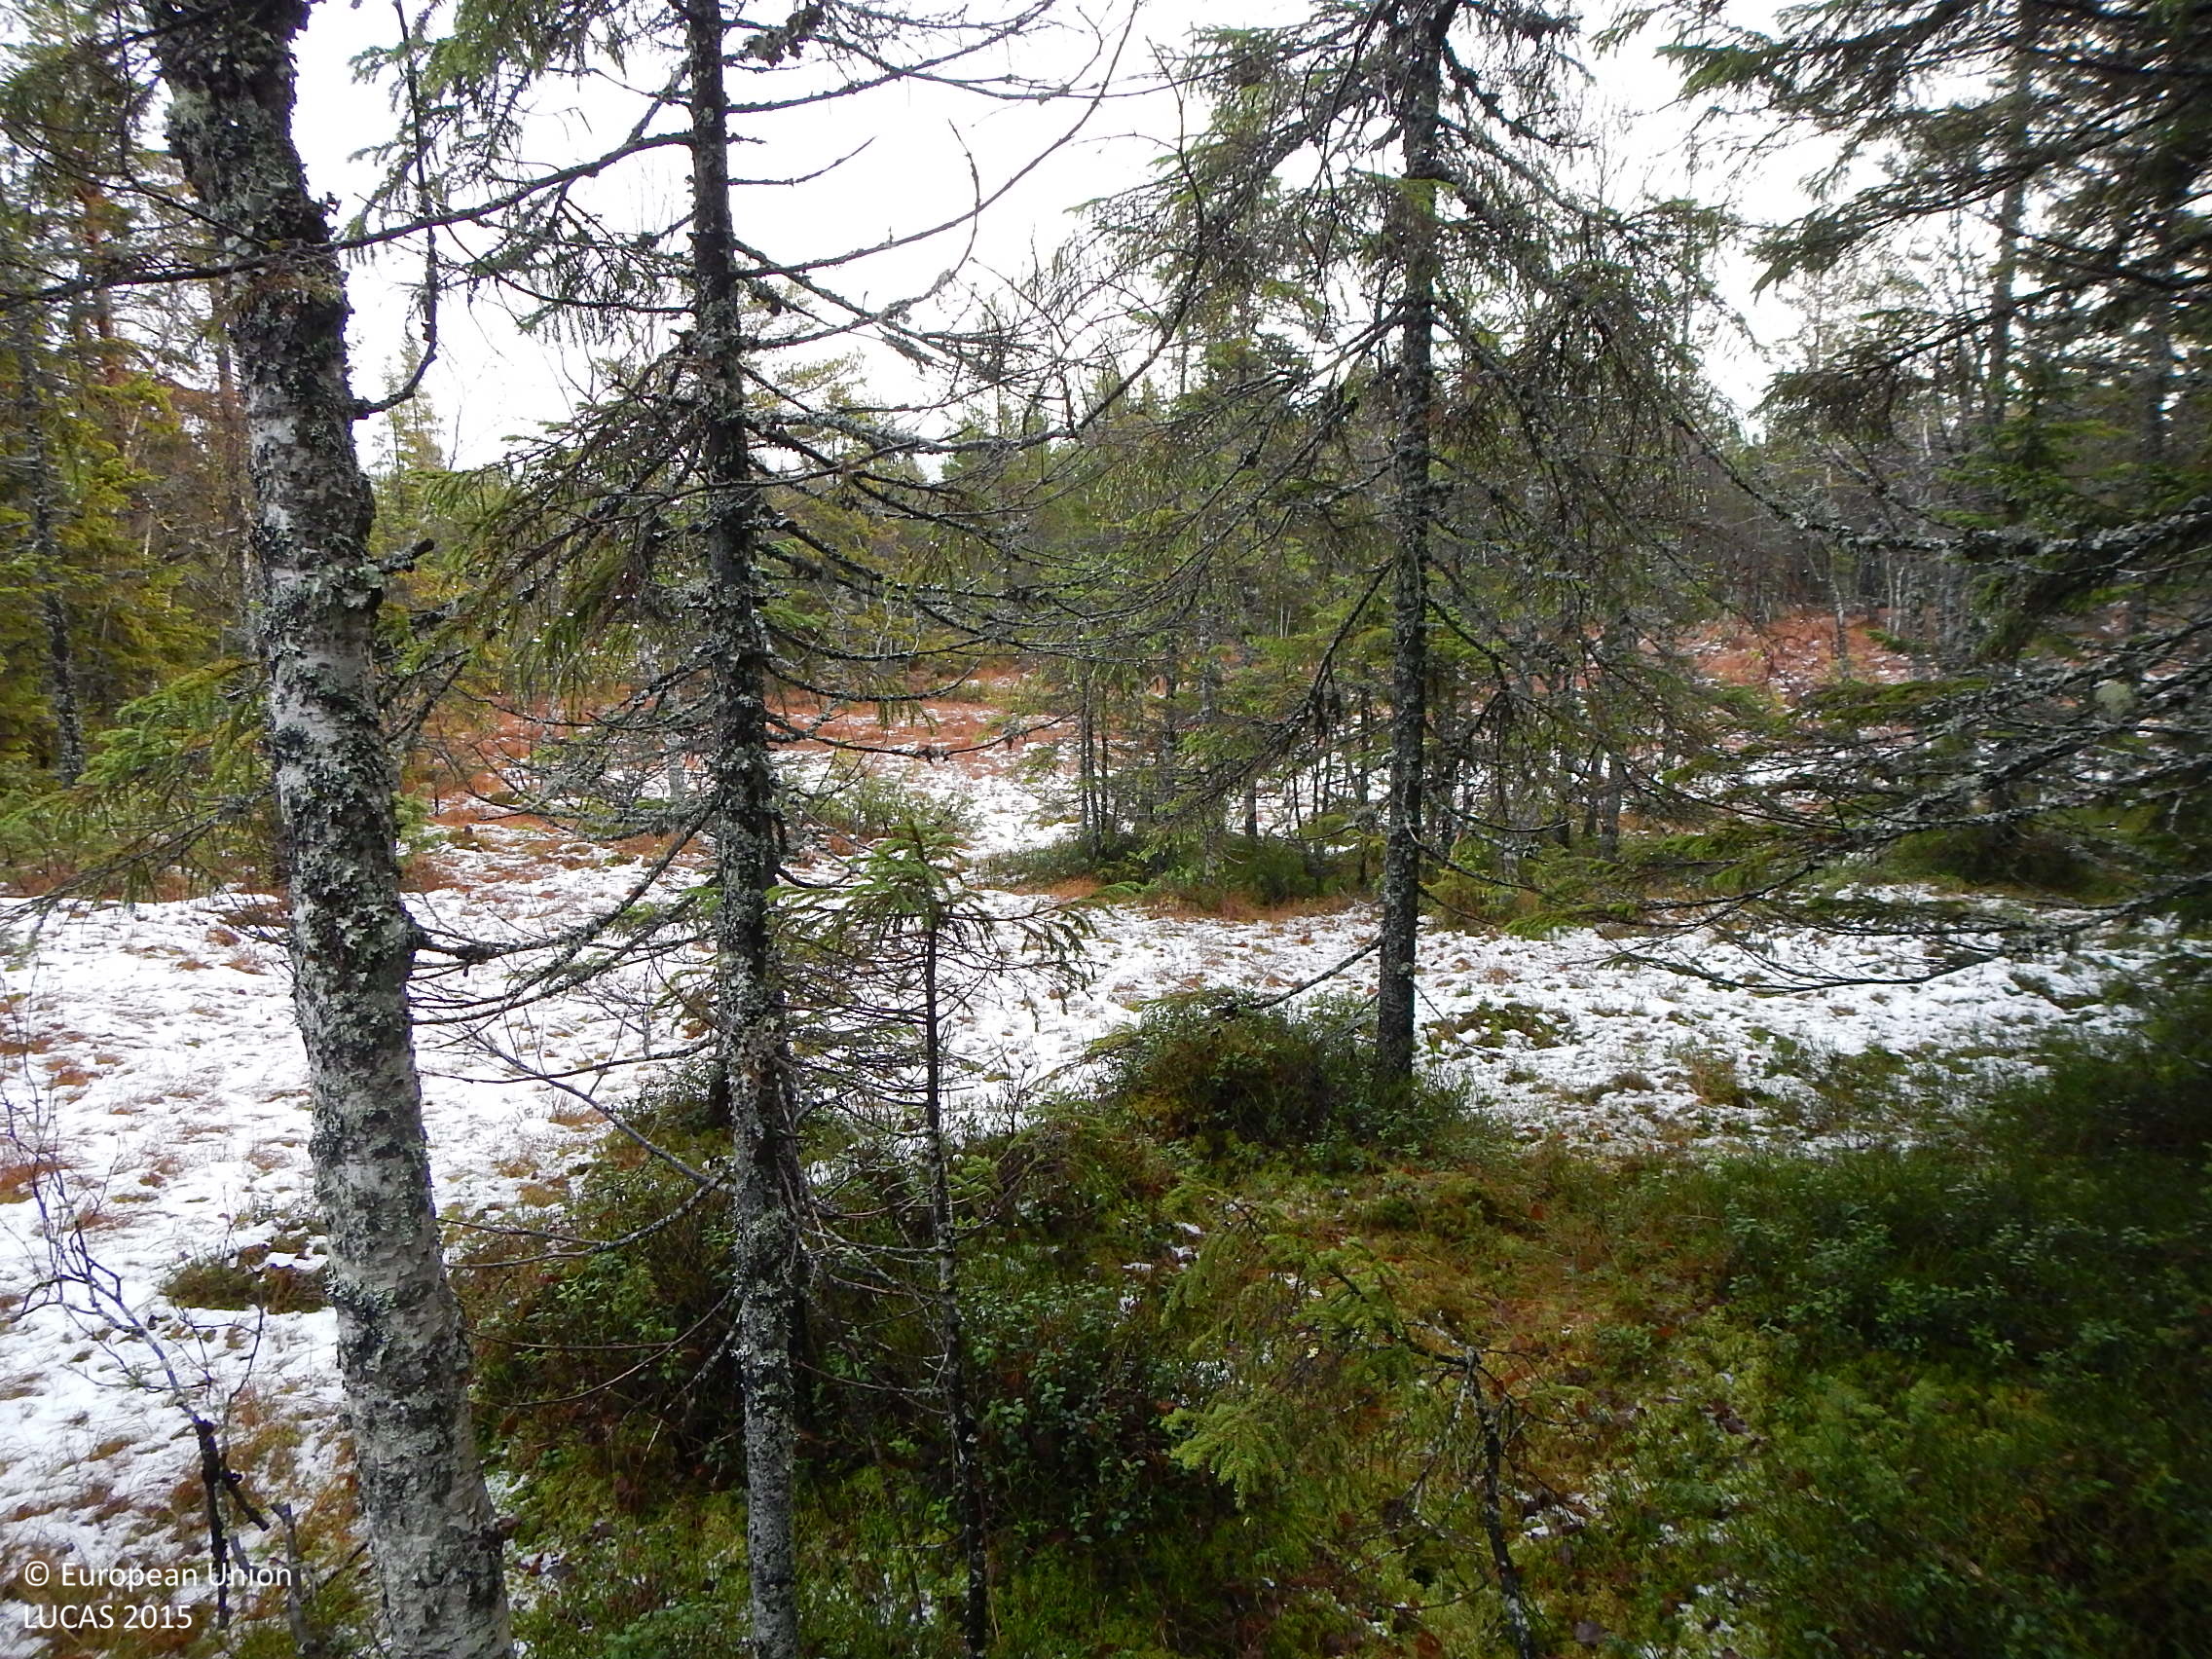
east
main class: Woodland
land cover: Other coniferous woodland
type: boreal forest
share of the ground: 50 - 75 %
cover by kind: coniferous forest trees 70 %, shrubs 20 %, lichens and mosses 10 %
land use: Amenities, museums, leisure
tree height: > 5 m
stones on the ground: < 10 %
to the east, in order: Other coniferous woodland; Ditches and canals; Other mixed woodland; Tracks; Other mixed woodland; Spruce dominated coniferous woodland; Ditches and canals; Other mixed woodland; Other coniferous woodland
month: November
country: SE
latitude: 61.6692
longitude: 16.6514
